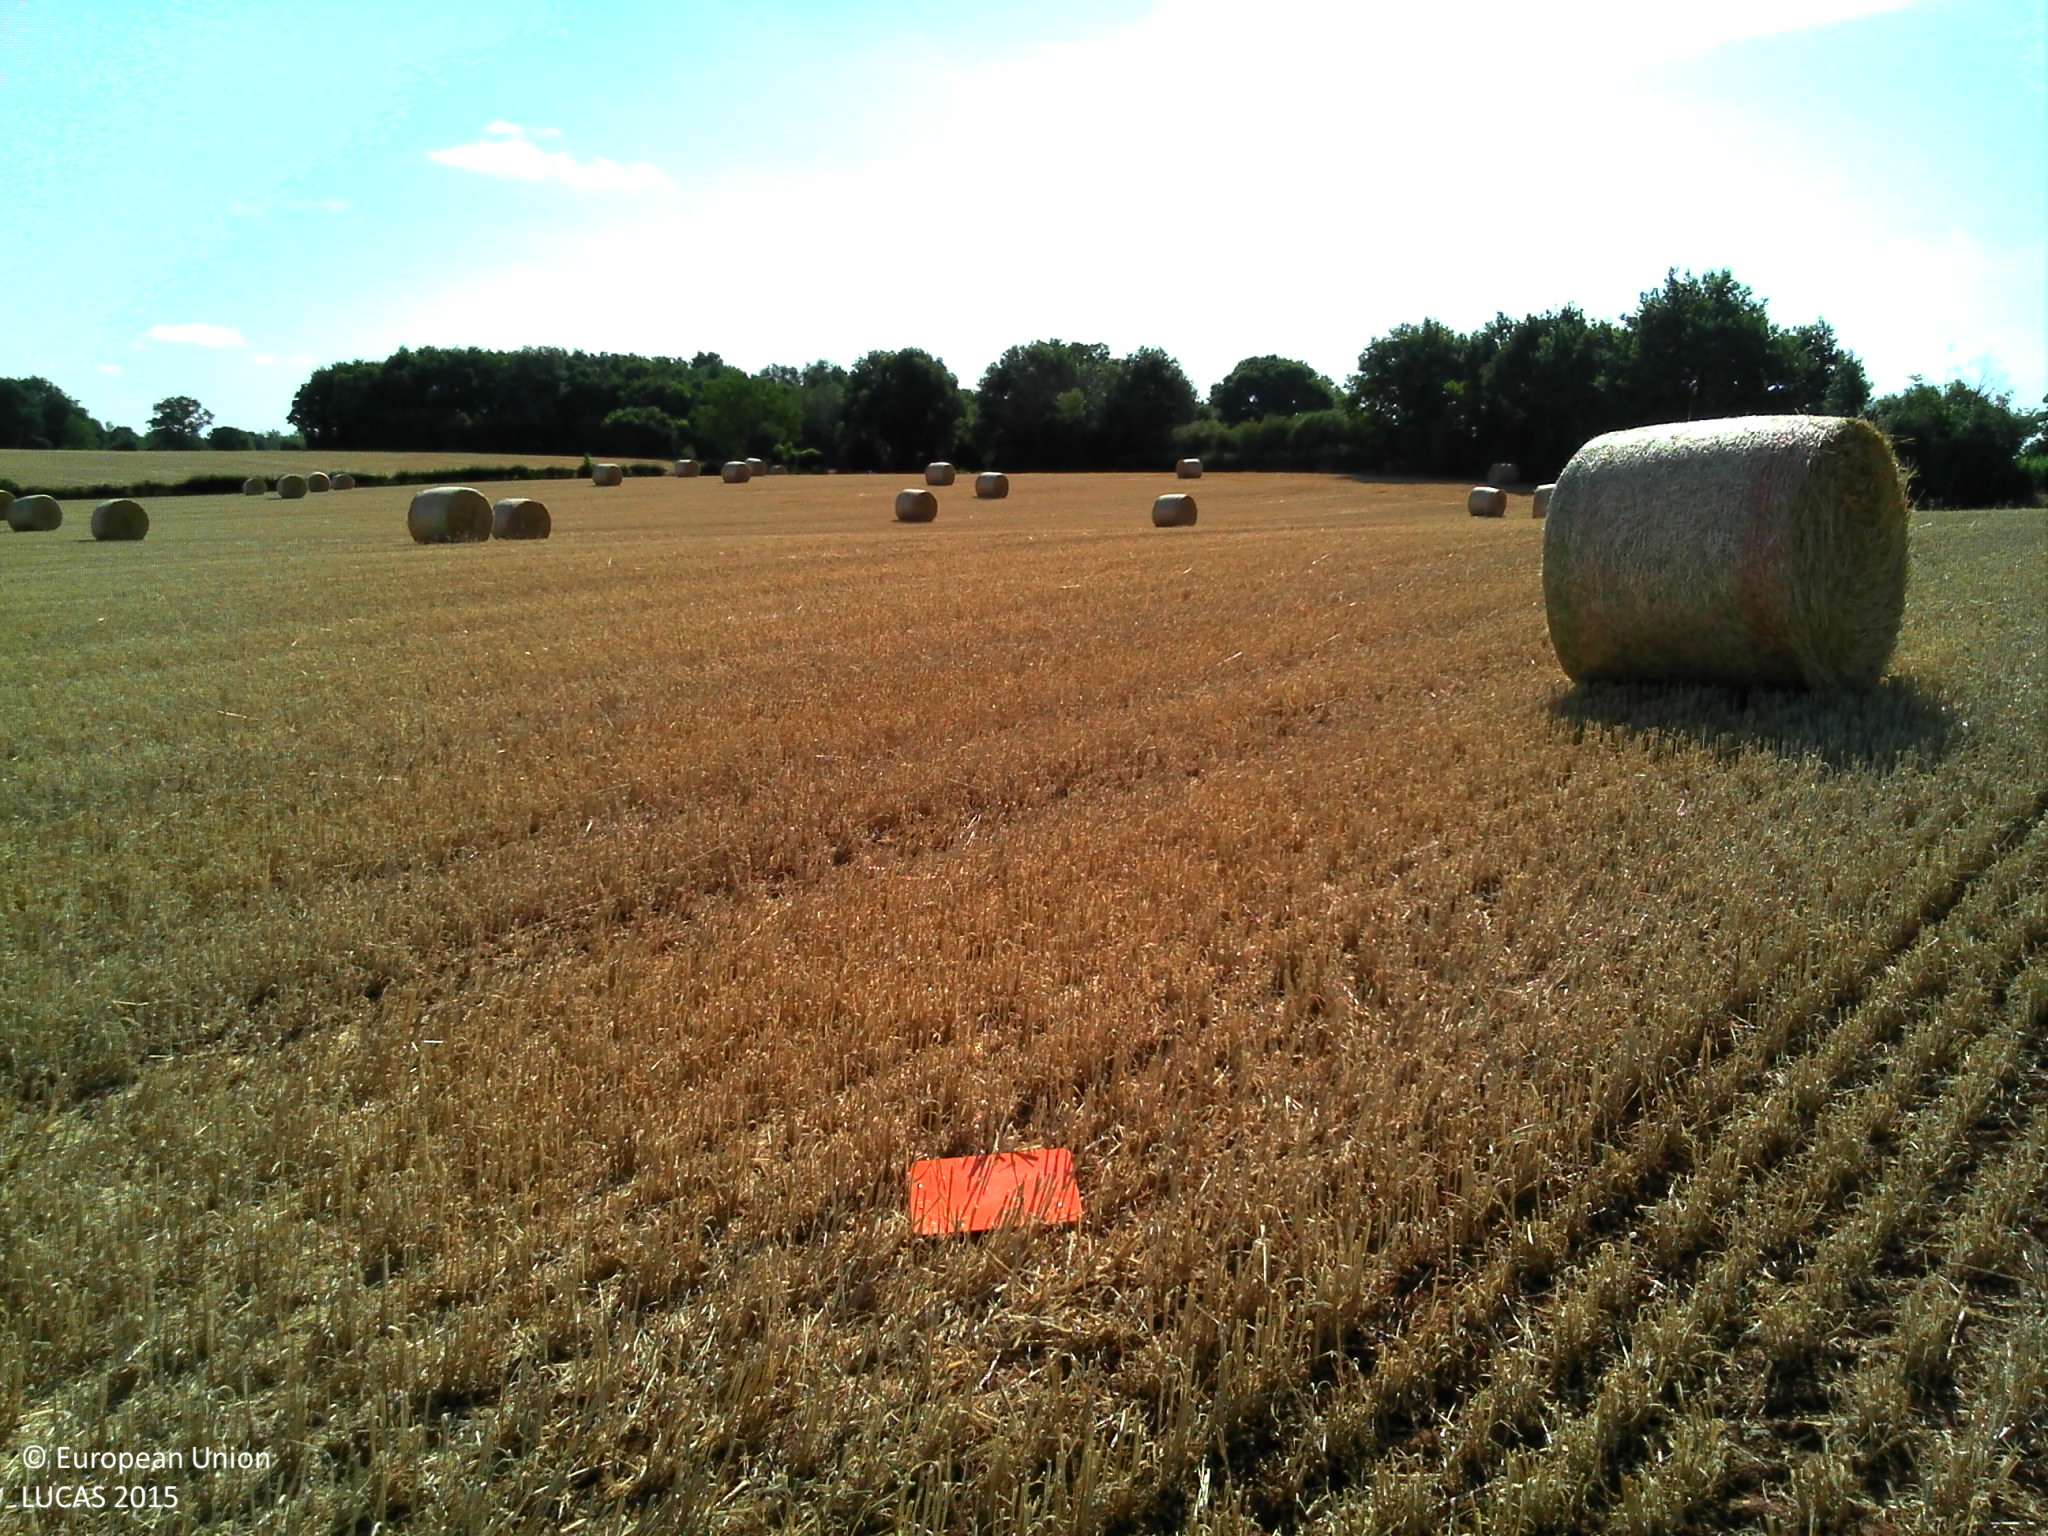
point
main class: Cropland
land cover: Common wheat
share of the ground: > 75 %
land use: Agriculture (excluding fallow land and kitchen gardens)
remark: Harvested field
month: July
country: FR
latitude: 46.2027
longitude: 0.5364
